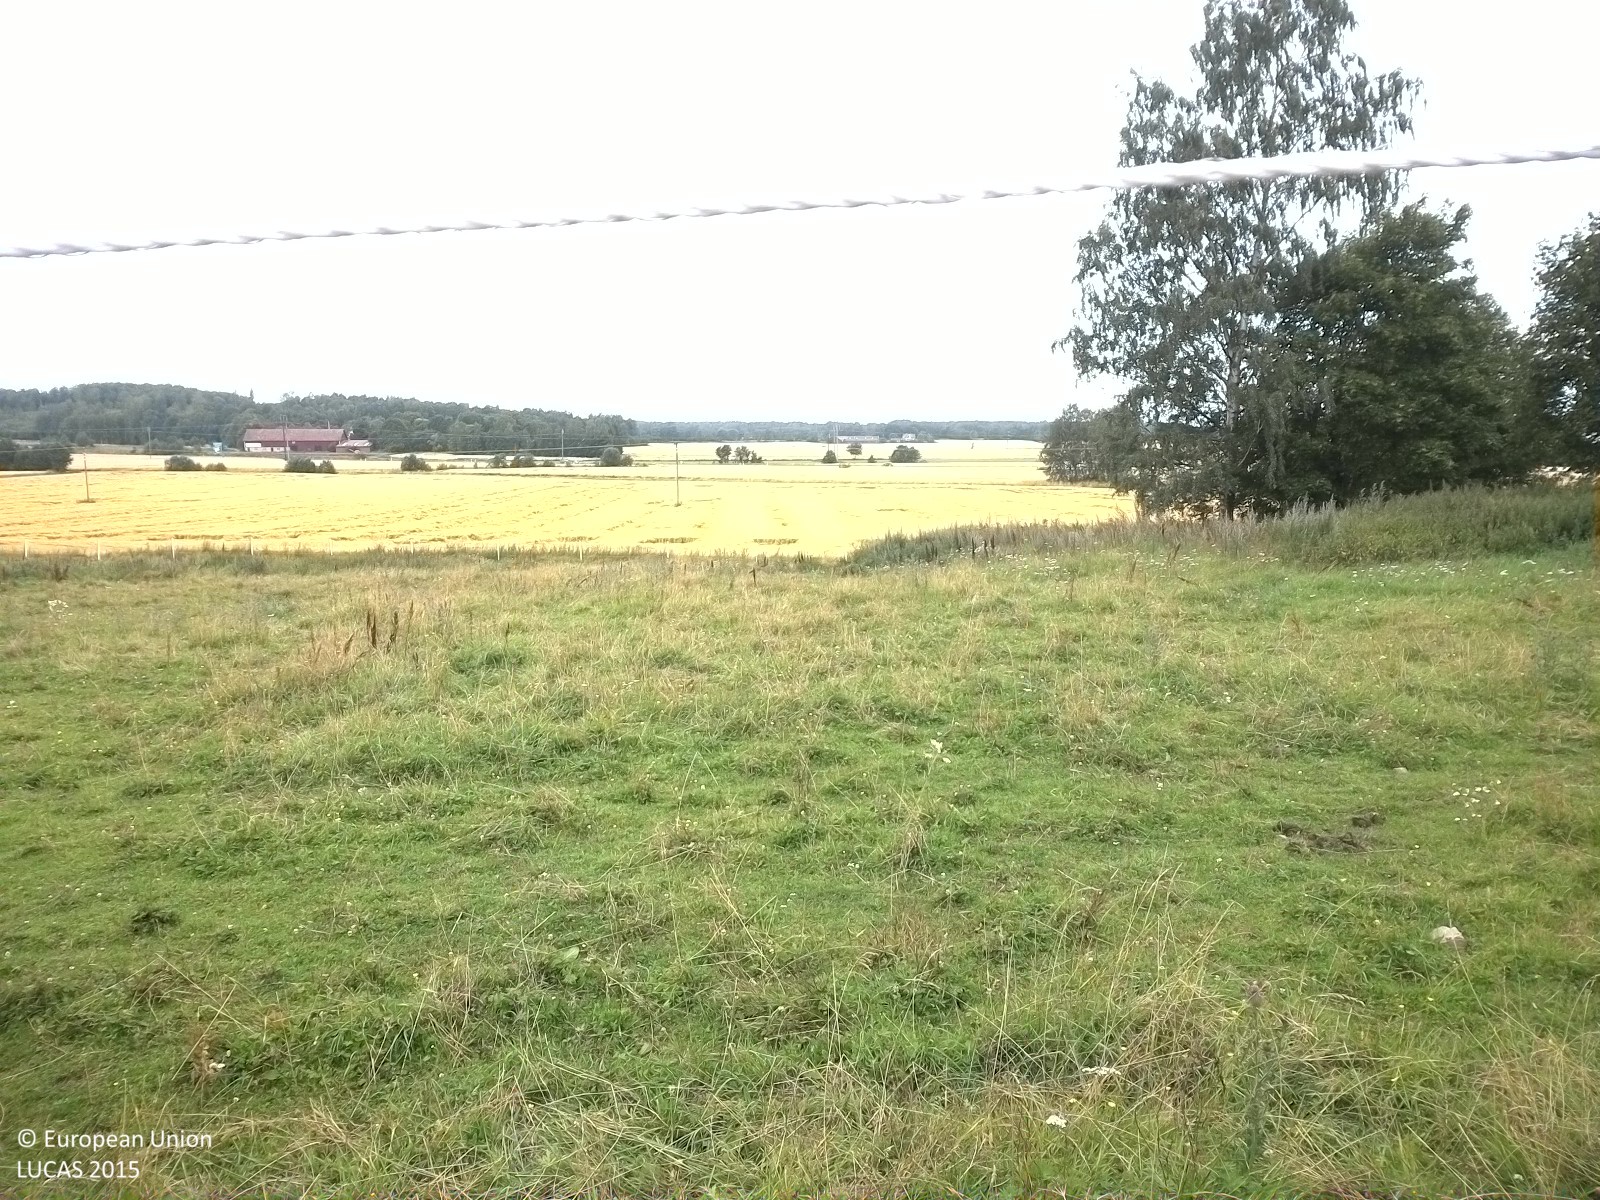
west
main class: Grassland
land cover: Grassland without tree/shrub cover
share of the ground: > 75 %
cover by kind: herbaceous plants 100 %
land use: Agriculture (excluding fallow land and kitchen gardens)
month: August
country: SE
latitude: 59.0808
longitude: 15.0347
